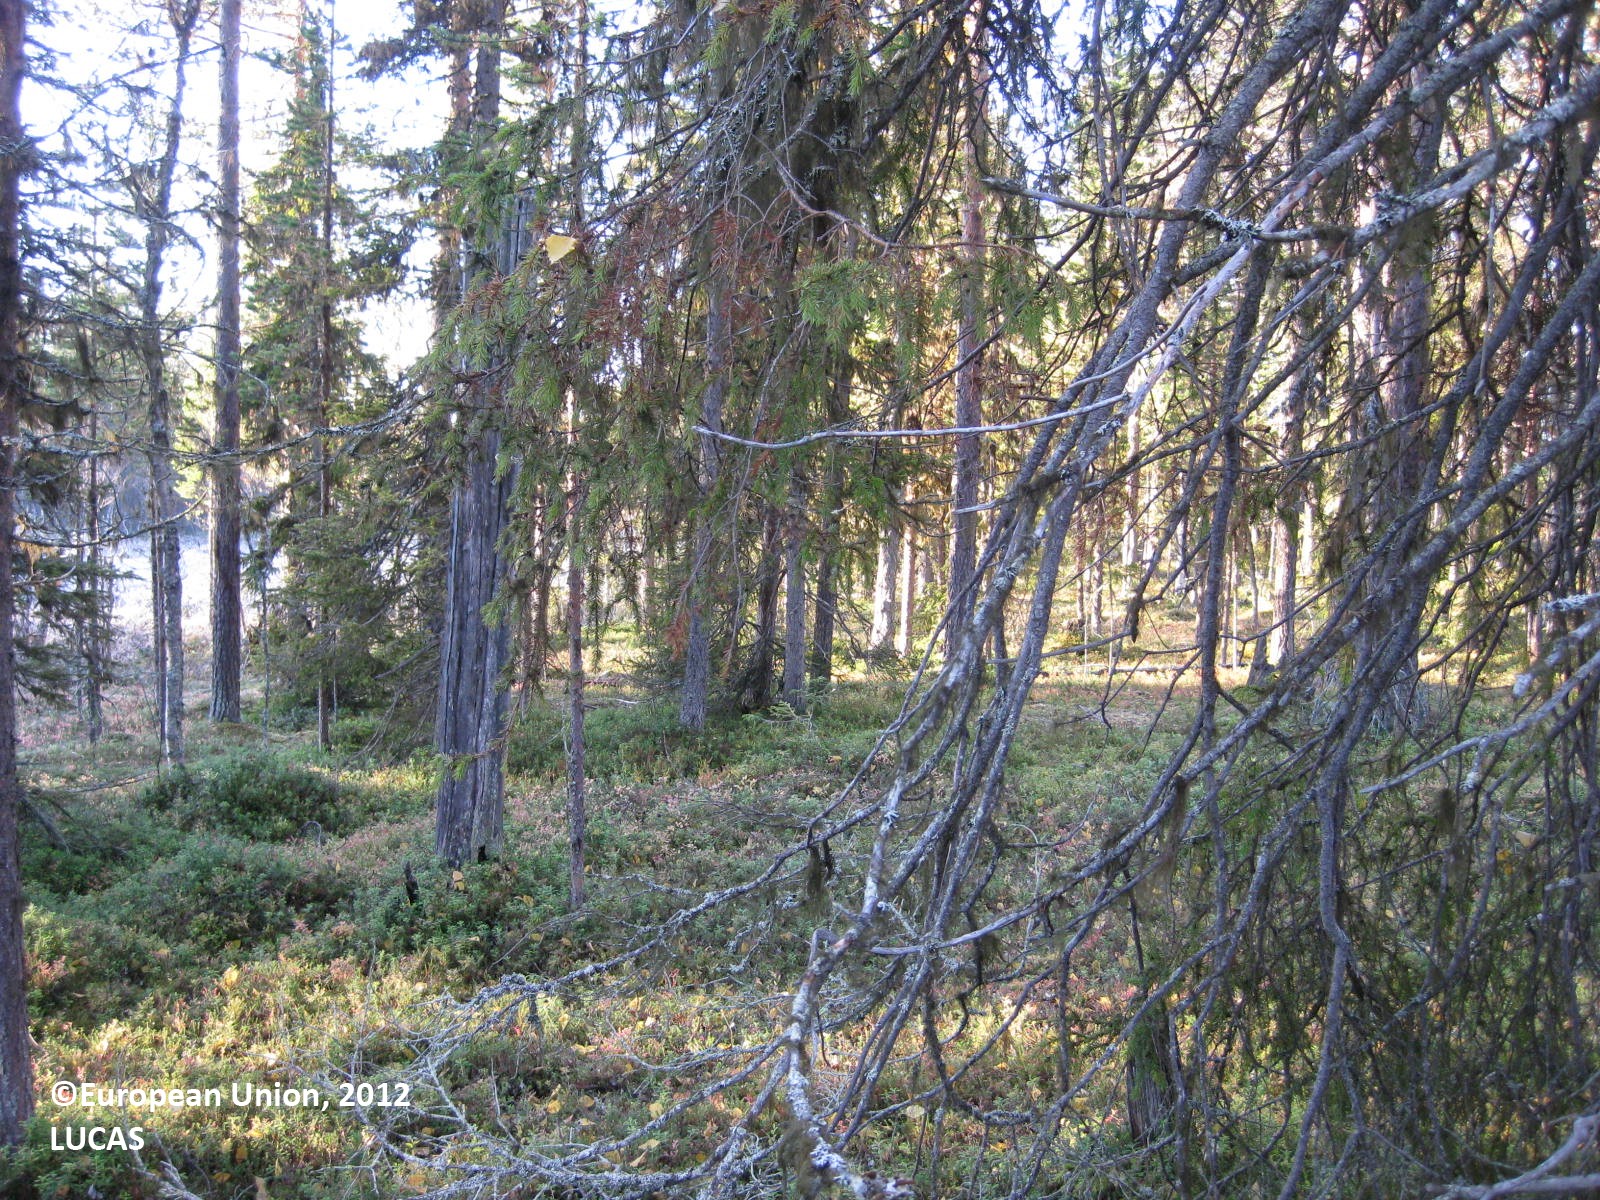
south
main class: Woodland
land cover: Other coniferous woodland
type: boreal forest
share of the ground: > 75 %
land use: Semi-natural and natural areas not in use
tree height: > 5 m
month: September
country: FI
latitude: 67.9583
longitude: 24.0332
